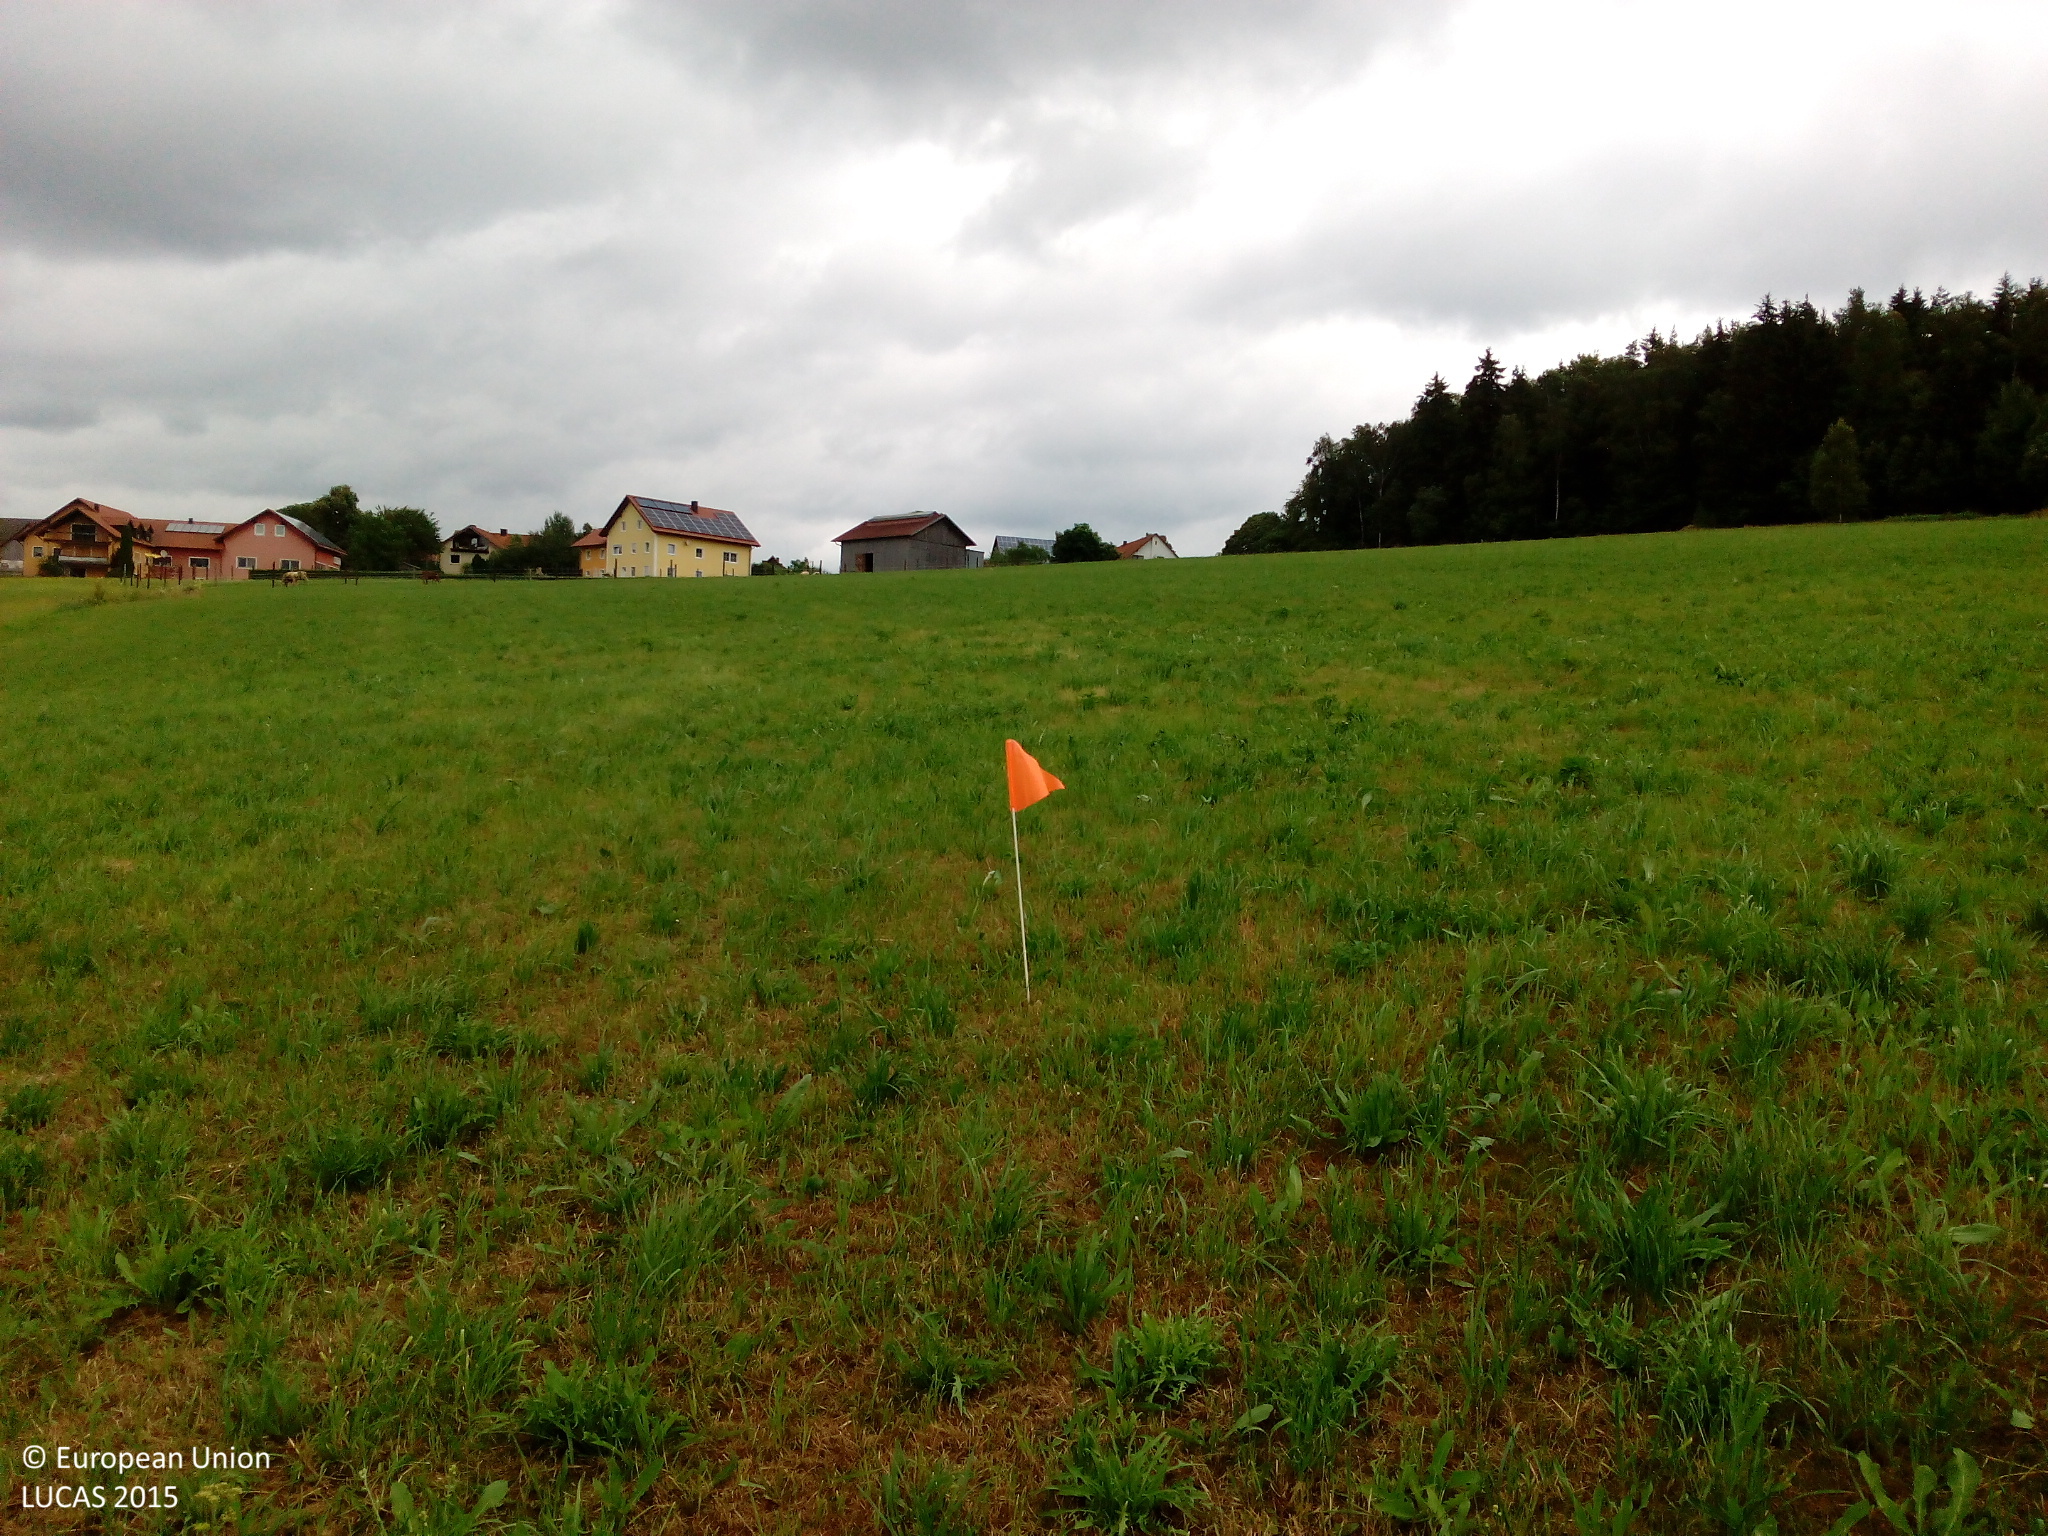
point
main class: Grassland
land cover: Grassland without tree/shrub cover
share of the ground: > 75 %
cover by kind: herbaceous plants 75 %, unconsolidated bare surface 5 %
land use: Agriculture (excluding fallow land and kitchen gardens)
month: July
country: DE
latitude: 49.4924
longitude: 12.4432
